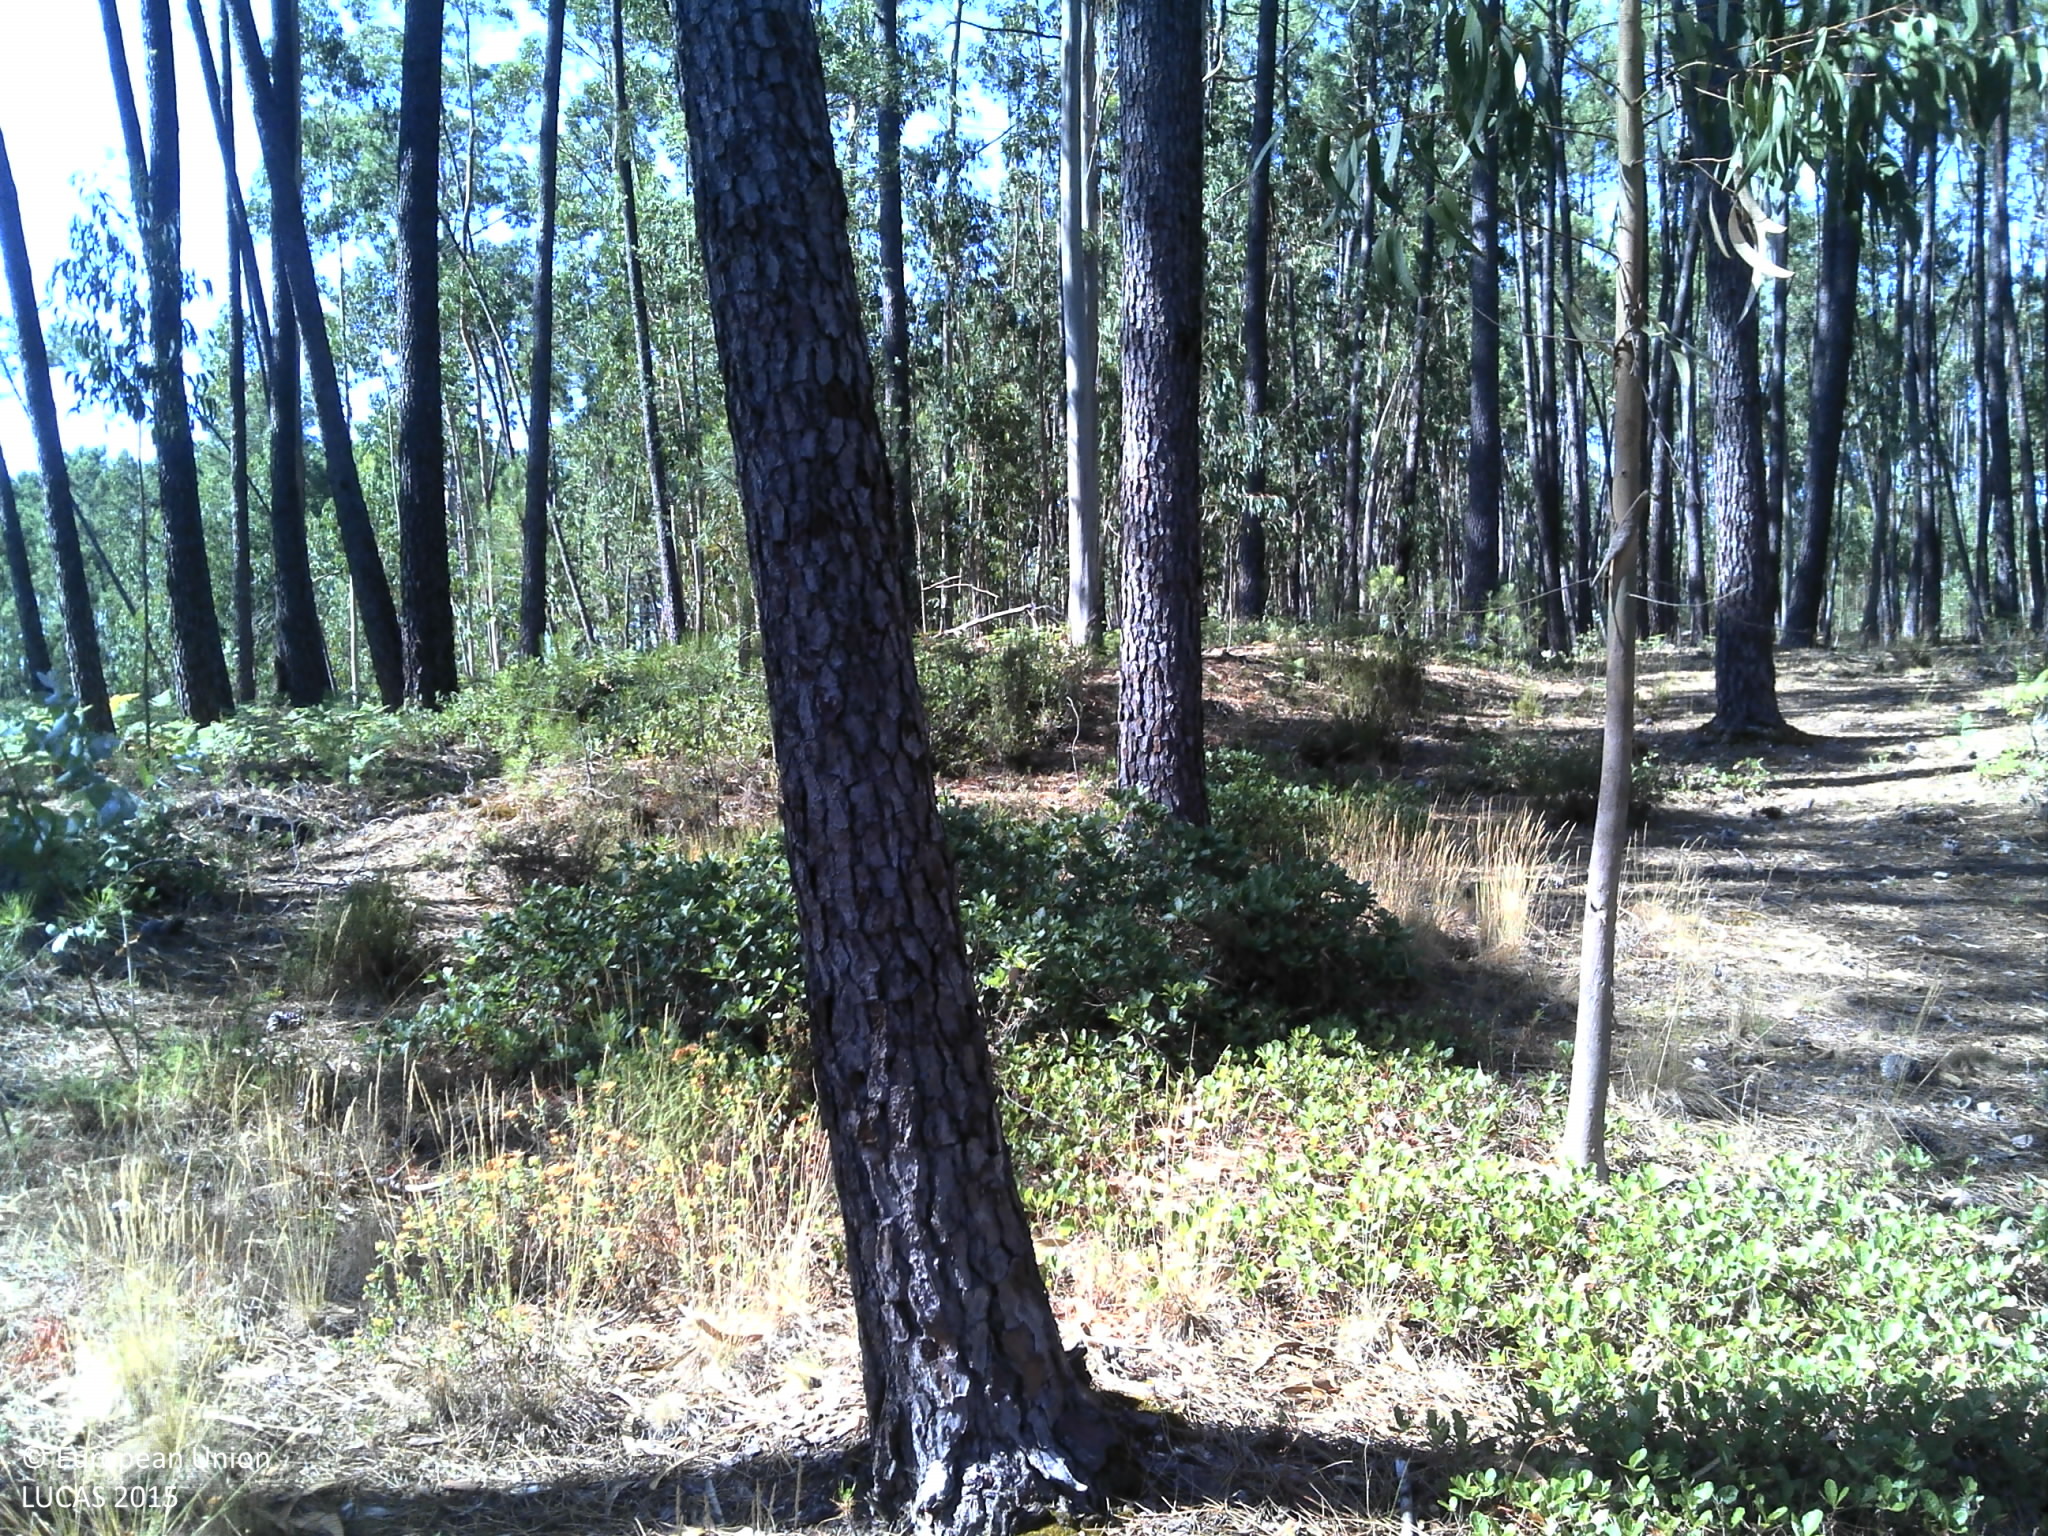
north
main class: Woodland
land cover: Pine dominated coniferous woodland
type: coniferous forest of the mediterranean region
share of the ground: 25 - 50 %
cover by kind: coniferous forest trees 50 %, unconsolidated bare surface 40 %, shrubs 10 %
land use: Forestry
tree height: > 5 m
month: July
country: PT
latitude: 39.7608
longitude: -8.5328
